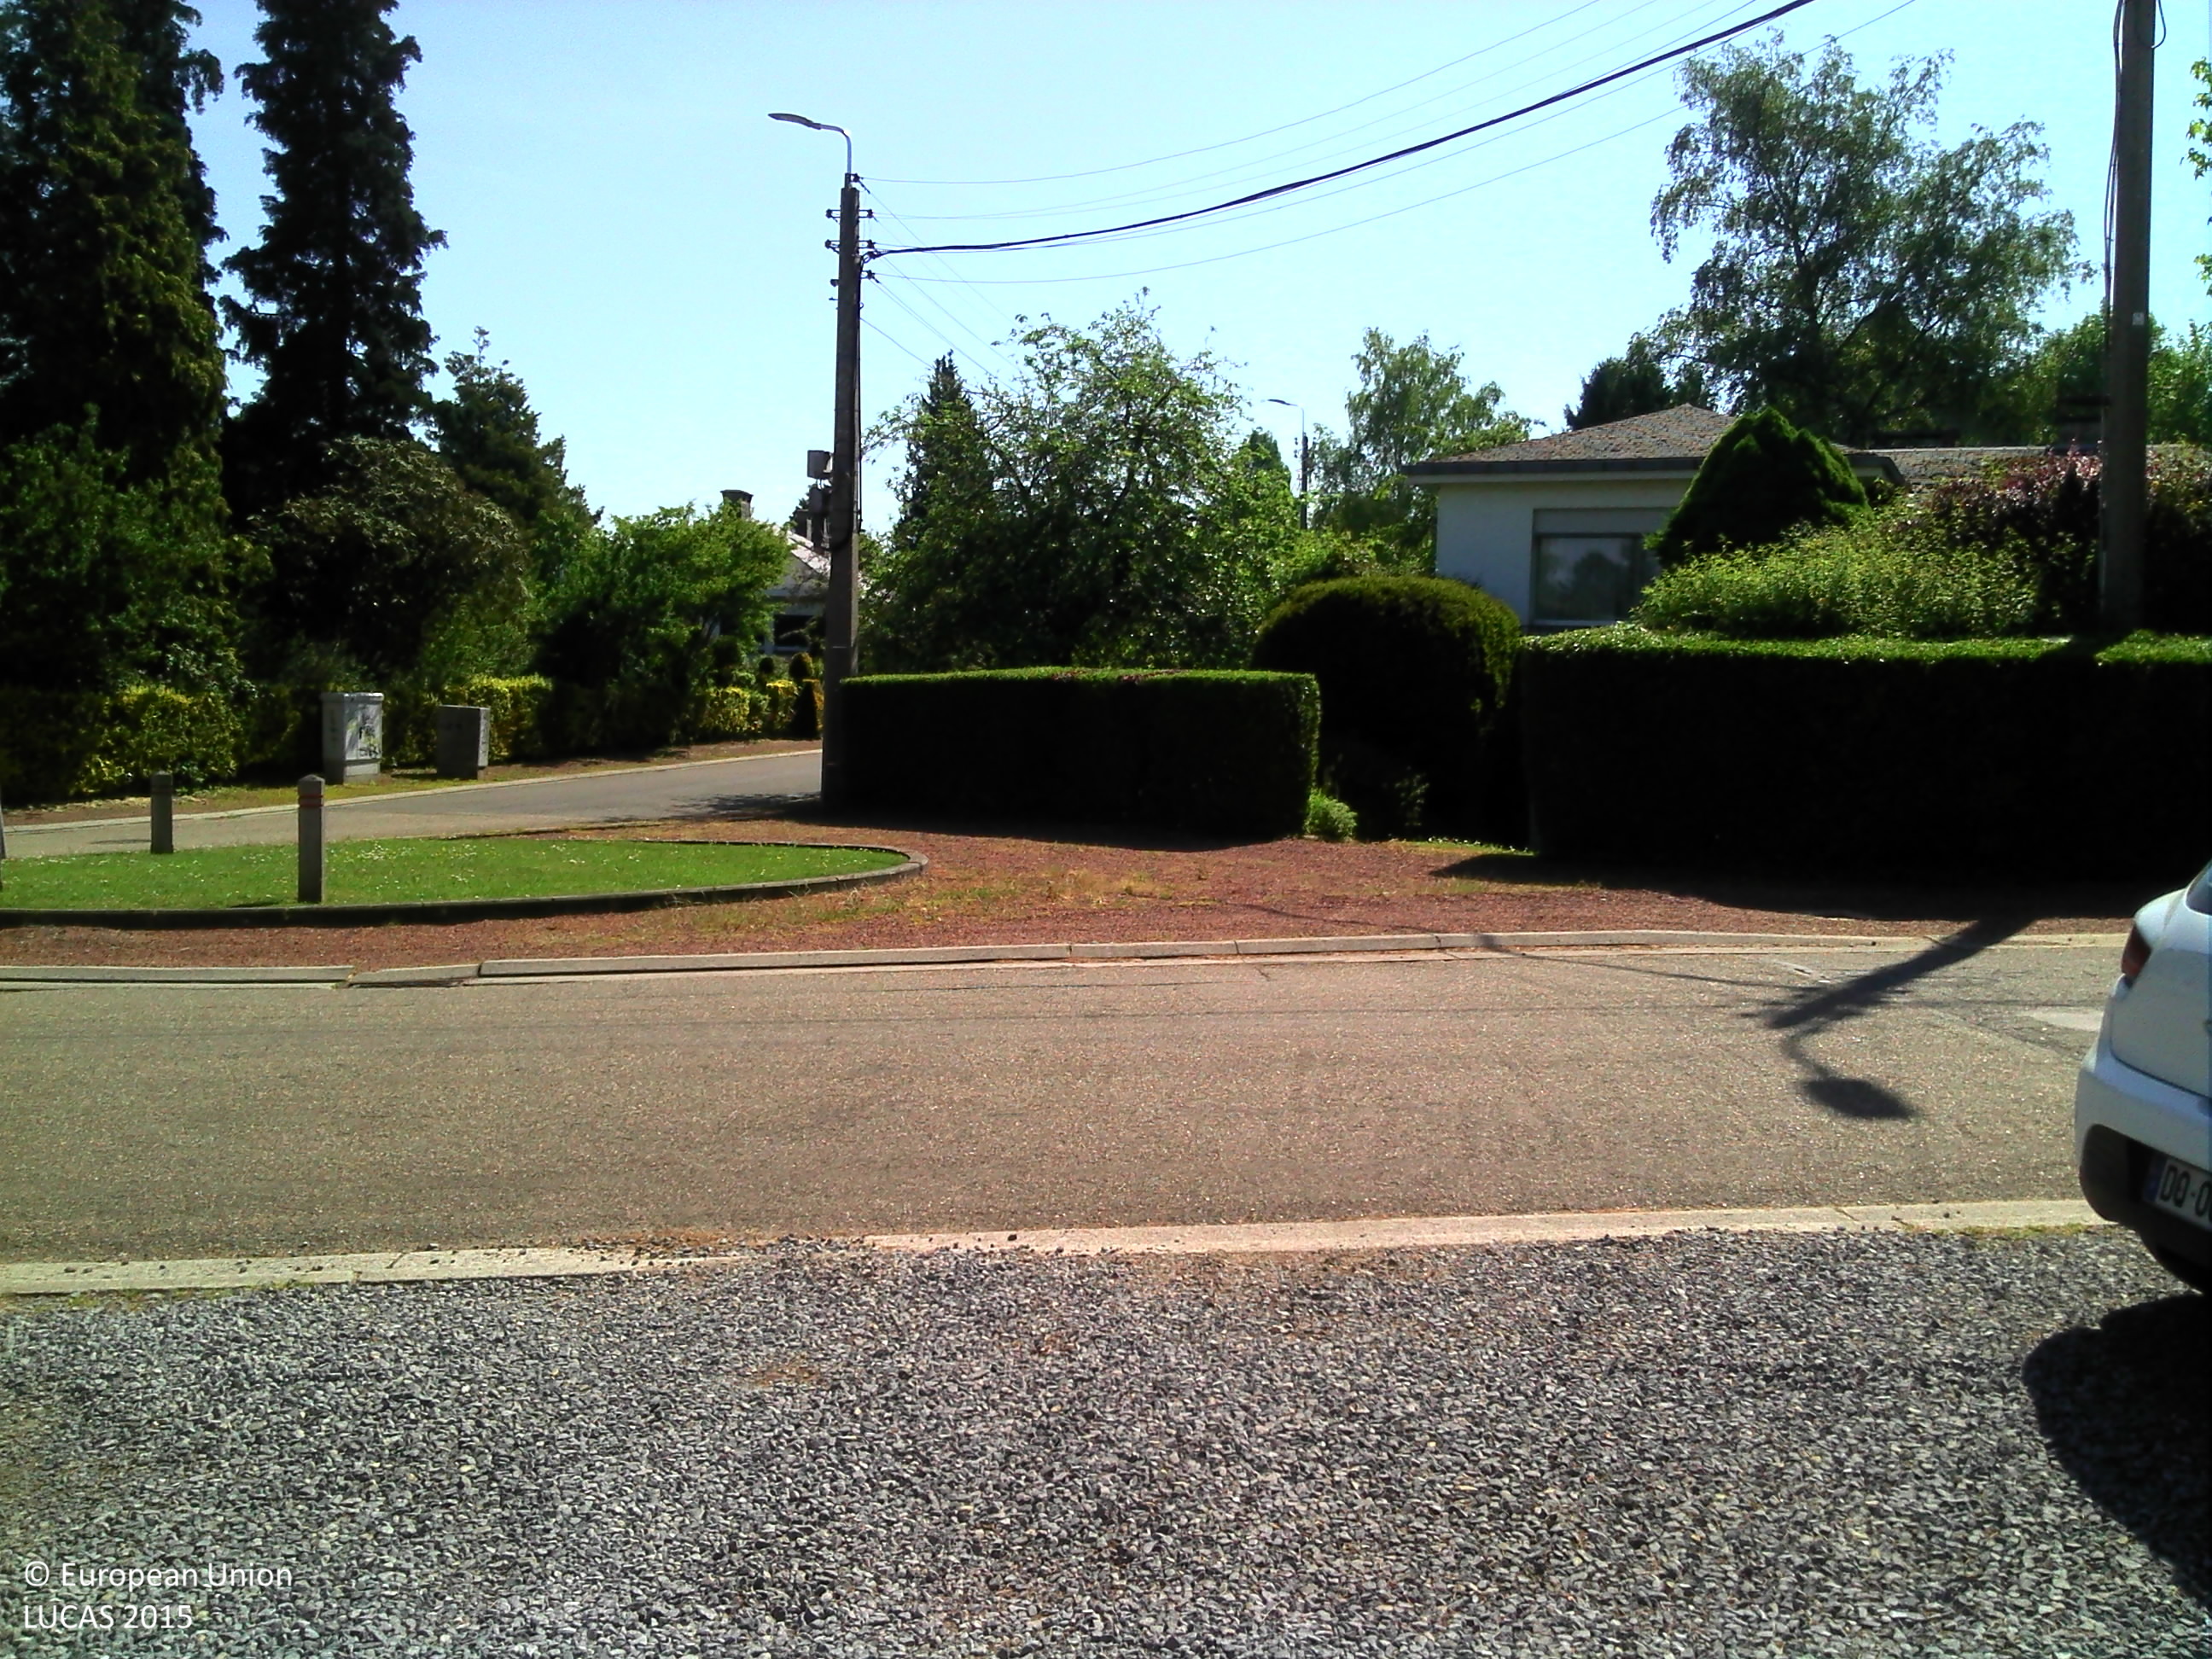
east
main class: Grassland
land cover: Grassland without tree/shrub cover
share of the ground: > 75 %
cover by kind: herbaceous plants 100 %
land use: Residential
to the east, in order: Grassland without tree/shrub cover; Artificial constructions in urban areas
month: June
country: BE
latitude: 50.5858
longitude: 5.6058
